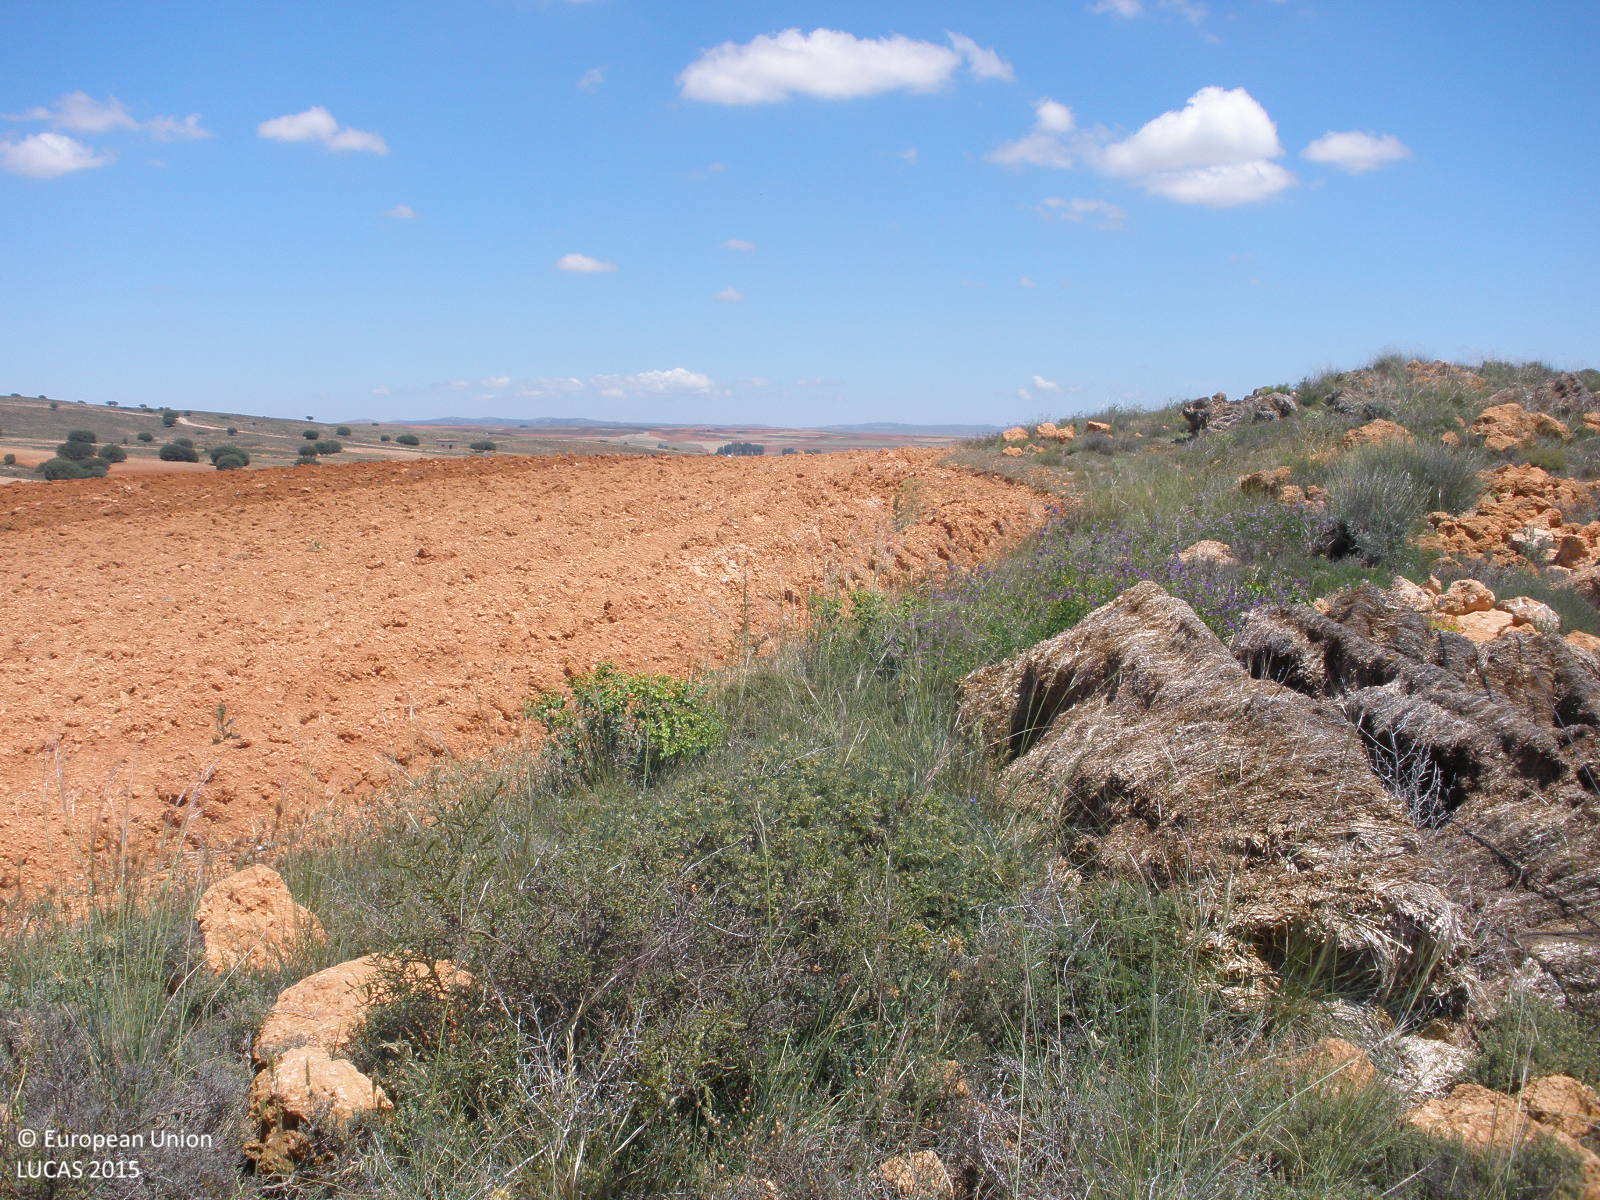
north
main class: Shrubland
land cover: Shrubland without tree cover
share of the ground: > 75 %
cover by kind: shrubs 75 %, consolidated bare surface 15 %, herbaceous plants 10 %
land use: Semi-natural and natural areas not in use
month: June
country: ES
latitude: 40.5680
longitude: -1.0803
